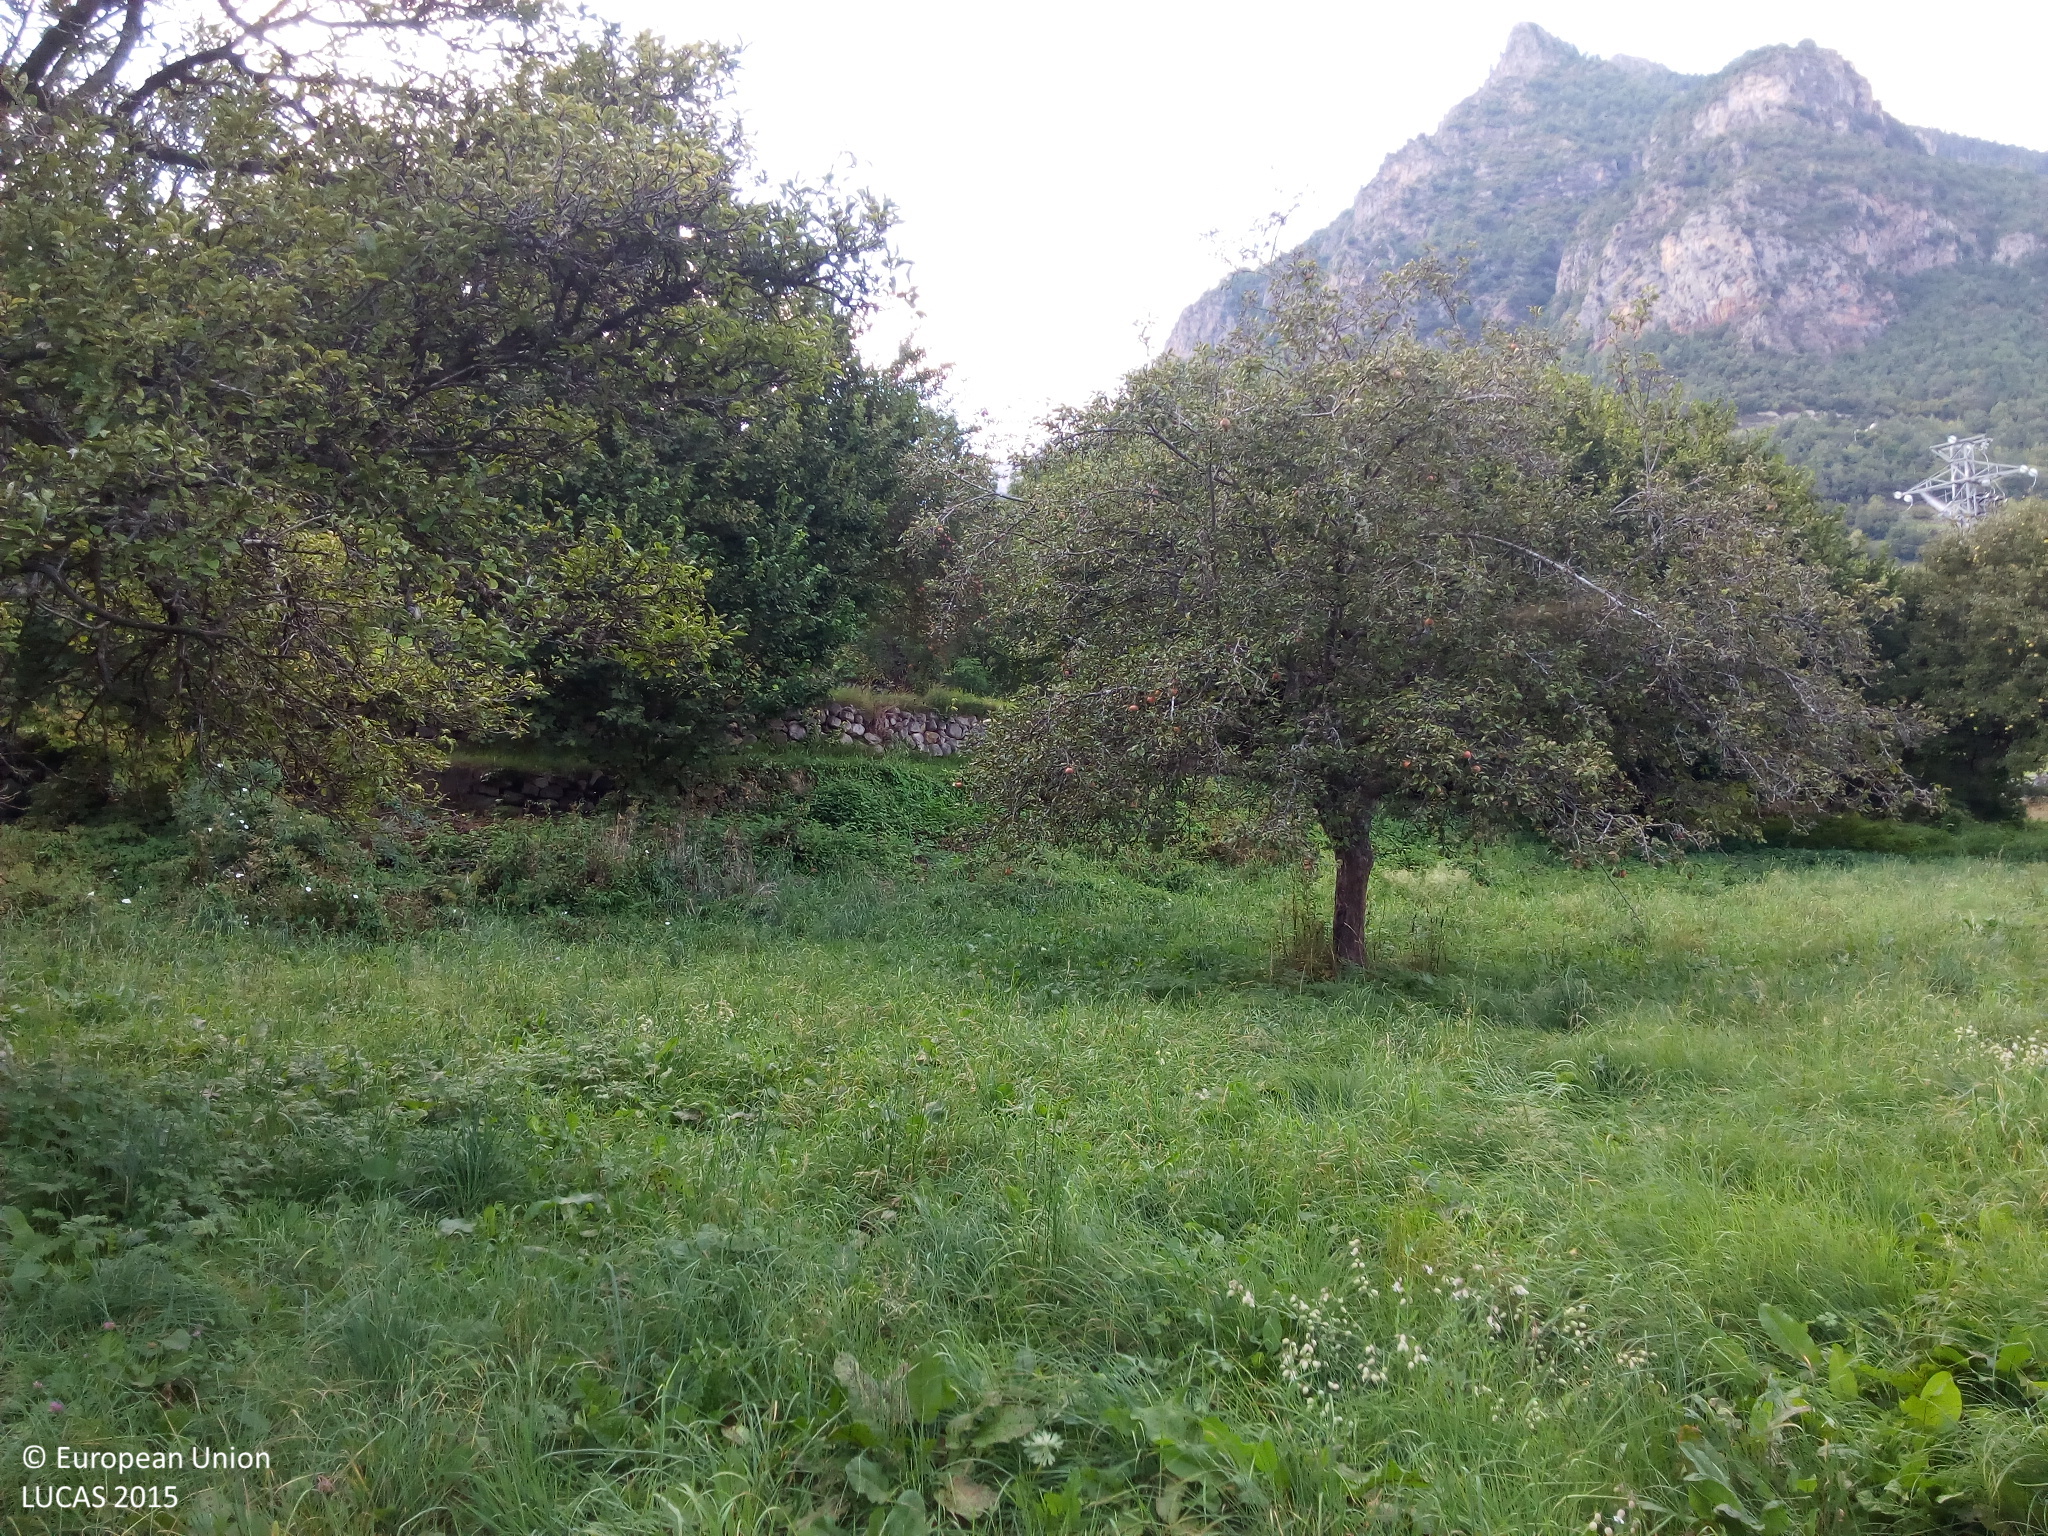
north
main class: Cropland
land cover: Apple fruit
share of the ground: > 75 %
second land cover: Spontaneously vegetated surfaces
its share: > 75 %
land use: Agriculture (excluding fallow land and kitchen gardens)
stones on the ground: < 10 %
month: September
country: ES
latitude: 42.5870
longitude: 0.4872
